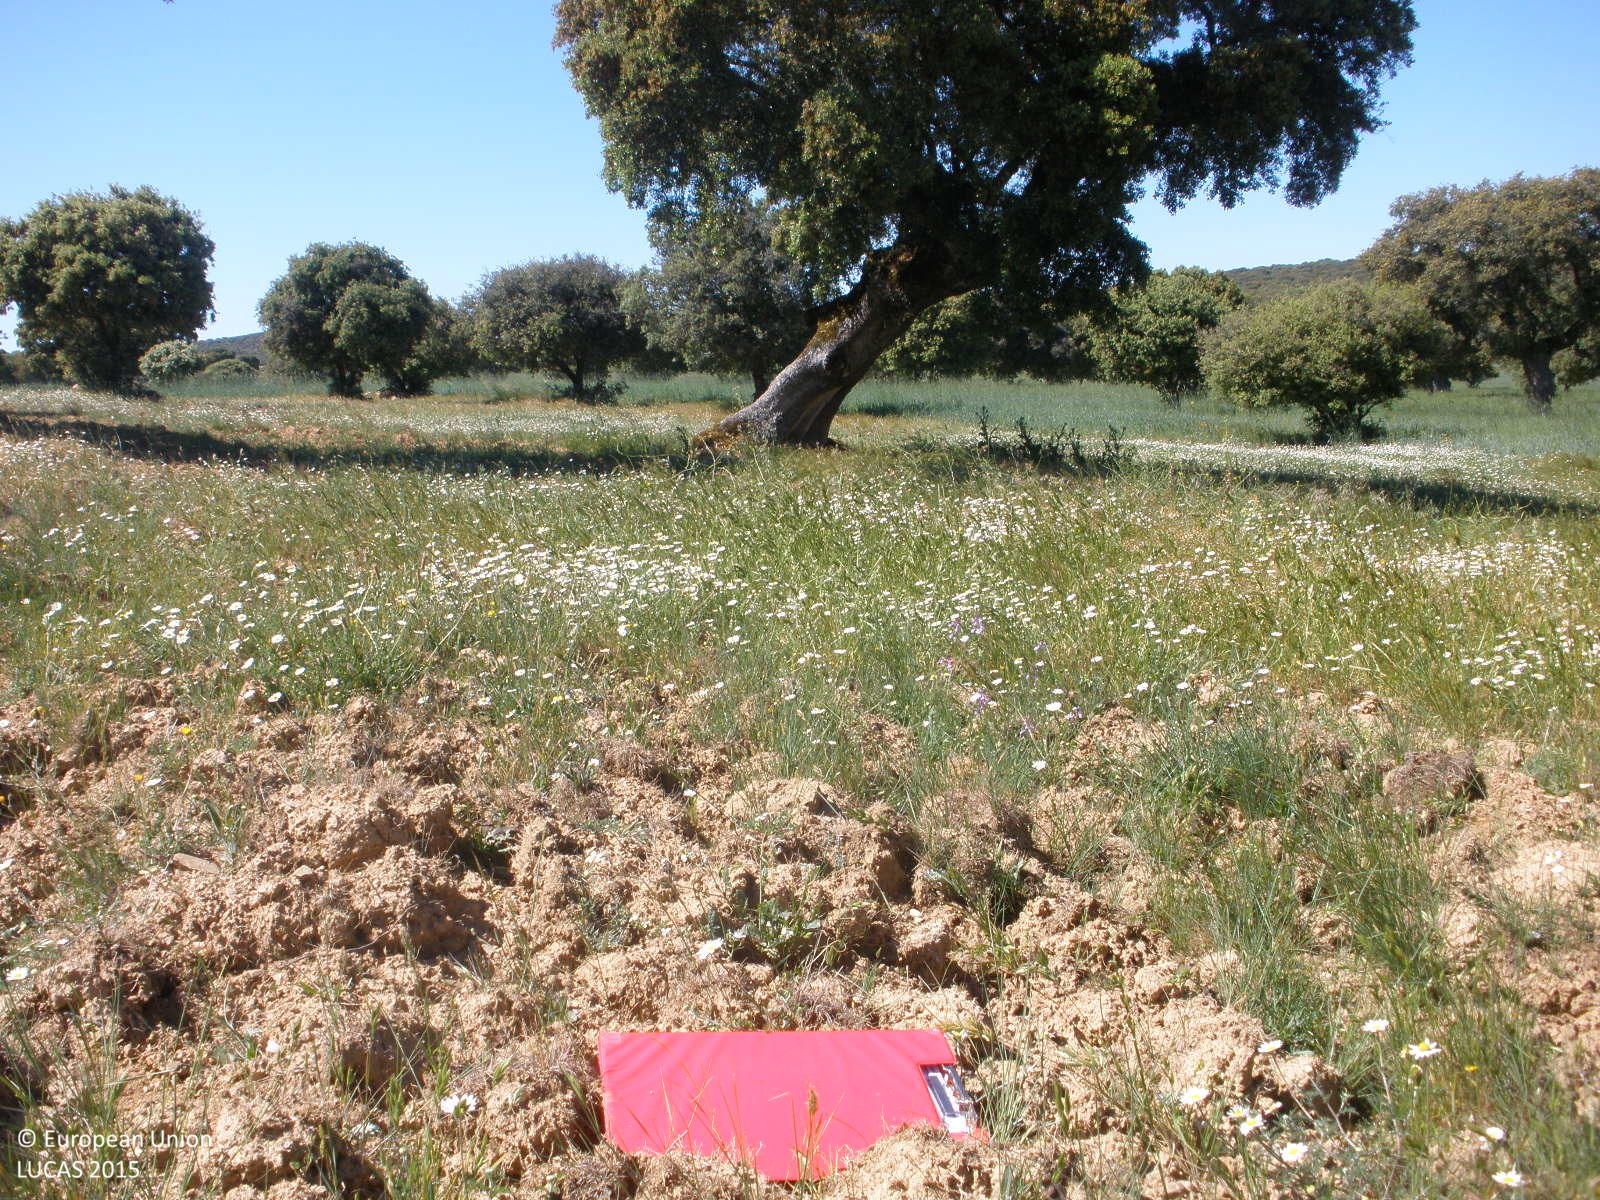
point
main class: Woodland
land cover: Broadleaved woodland
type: broadleaved evergreen forest
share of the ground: 25 - 50 %
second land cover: Grassland without tree/shrub cover
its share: 50 - 75 %
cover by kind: herbaceous plants 50 %, broadleaved forest trees 30 %, unconsolidated bare surface 20 %
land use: Forestry
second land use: Agriculture (excluding fallow land and kitchen gardens)
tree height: < 5 m
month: May
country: ES
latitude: 40.6980
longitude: -5.8526
